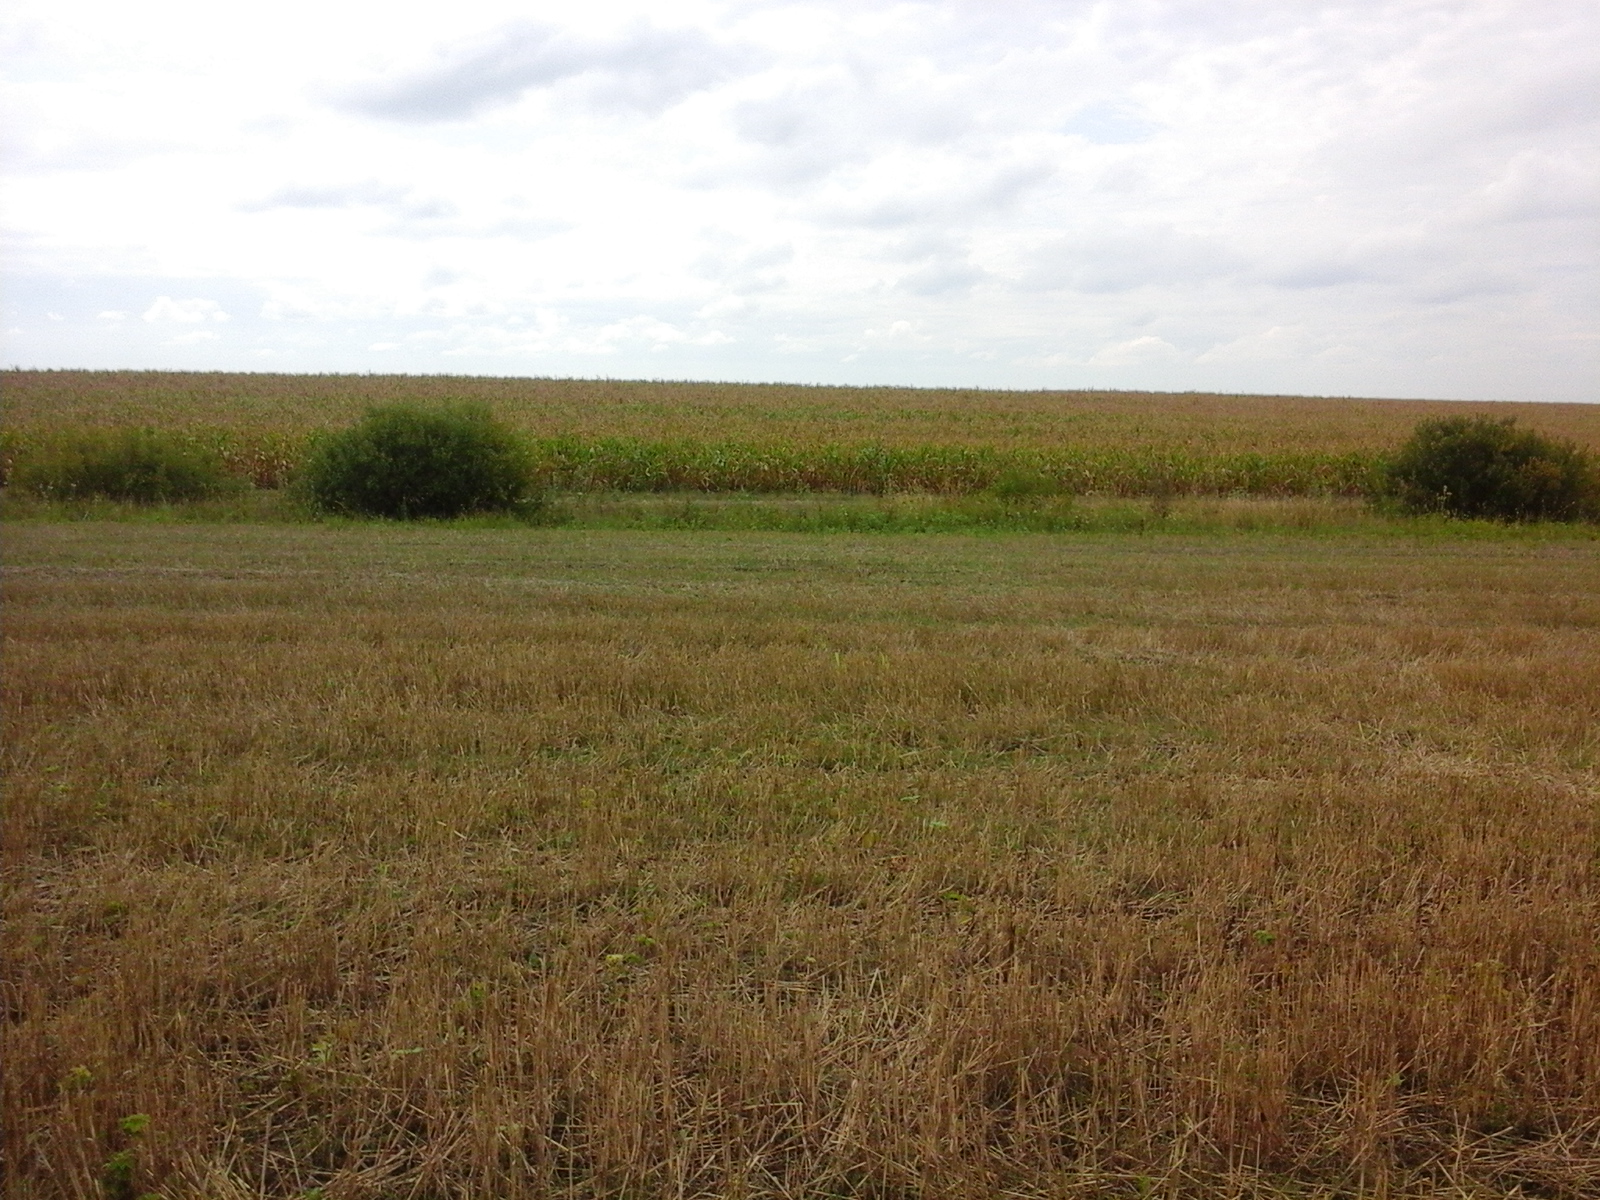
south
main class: Cropland
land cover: Common wheat
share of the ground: 50 - 75 %
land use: Agriculture (excluding fallow land and kitchen gardens)
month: August
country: RO
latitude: 45.5487
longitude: 21.3149
